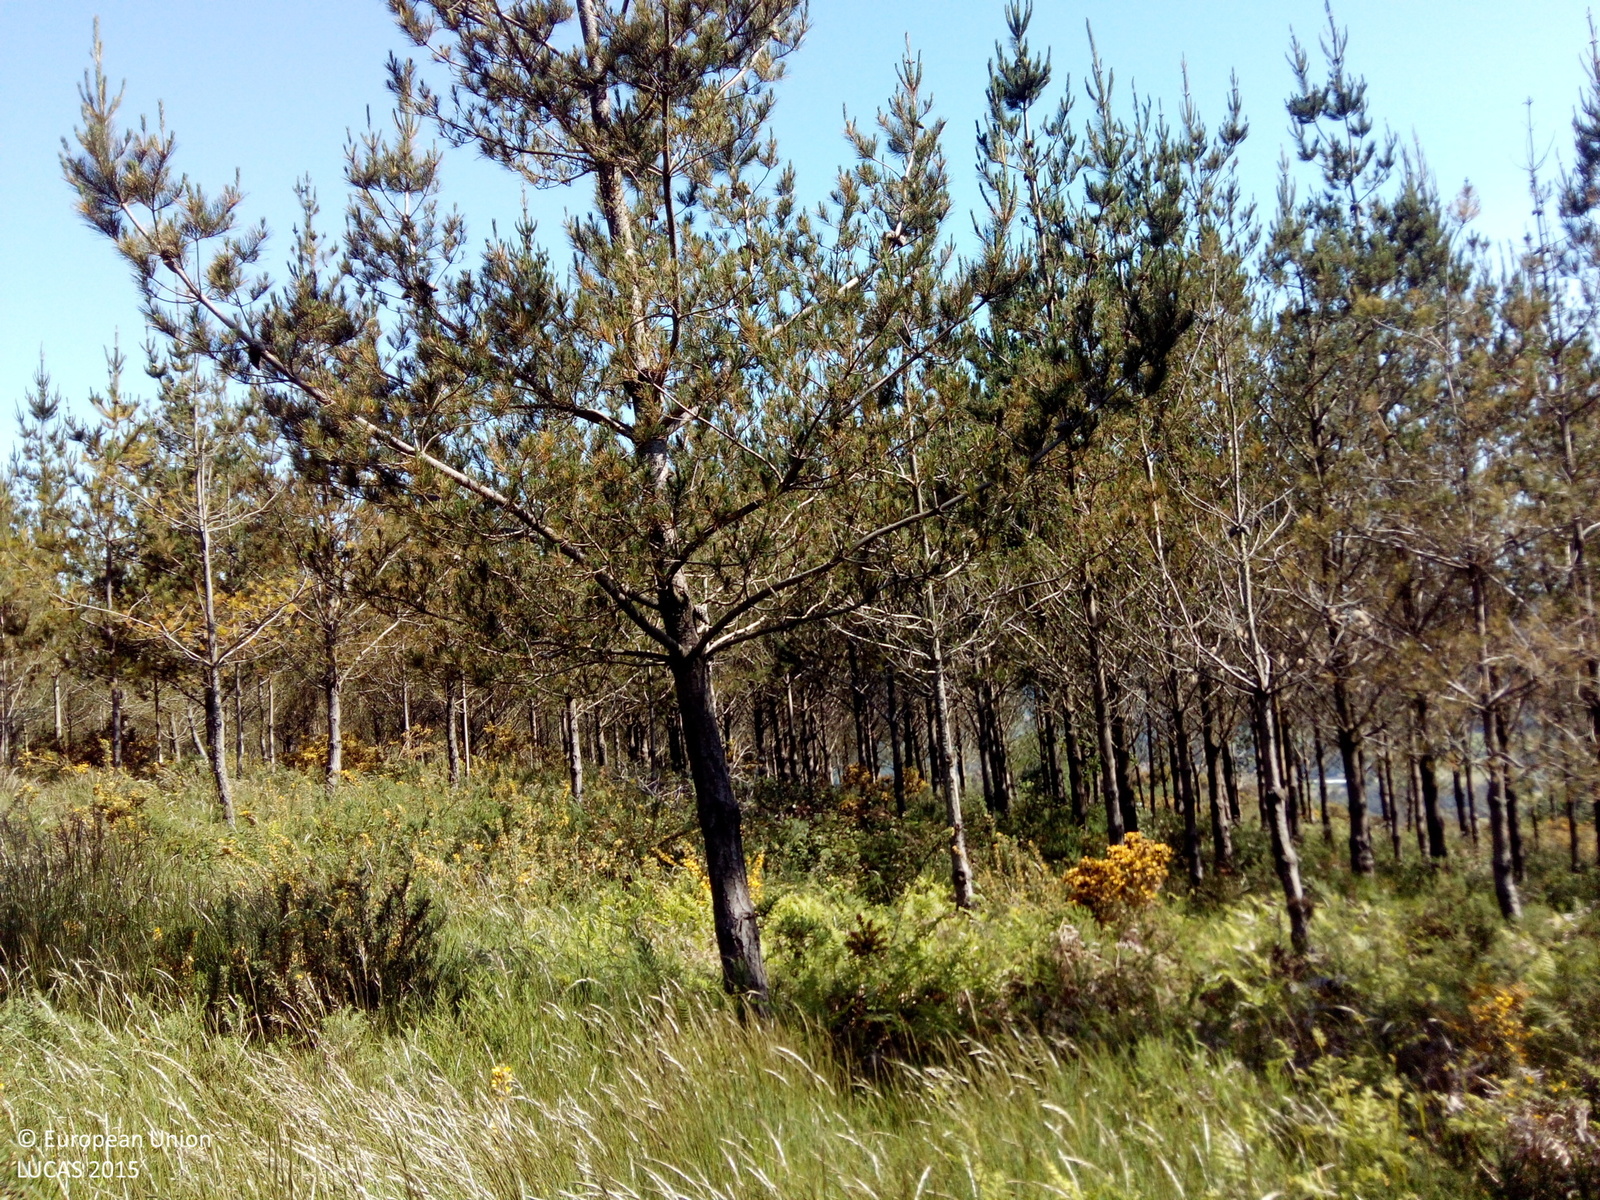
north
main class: Woodland
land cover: Pine dominated coniferous woodland
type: hemiboreal forest and nemoral coniferous forest and mixed broadleaved-coniferous forest
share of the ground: > 75 %
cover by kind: coniferous forest trees 75 %, herbaceous plants 20 %, shrubs 5 %
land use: Forestry
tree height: > 5 m
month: May
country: ES
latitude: 42.6669
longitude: -8.4115
